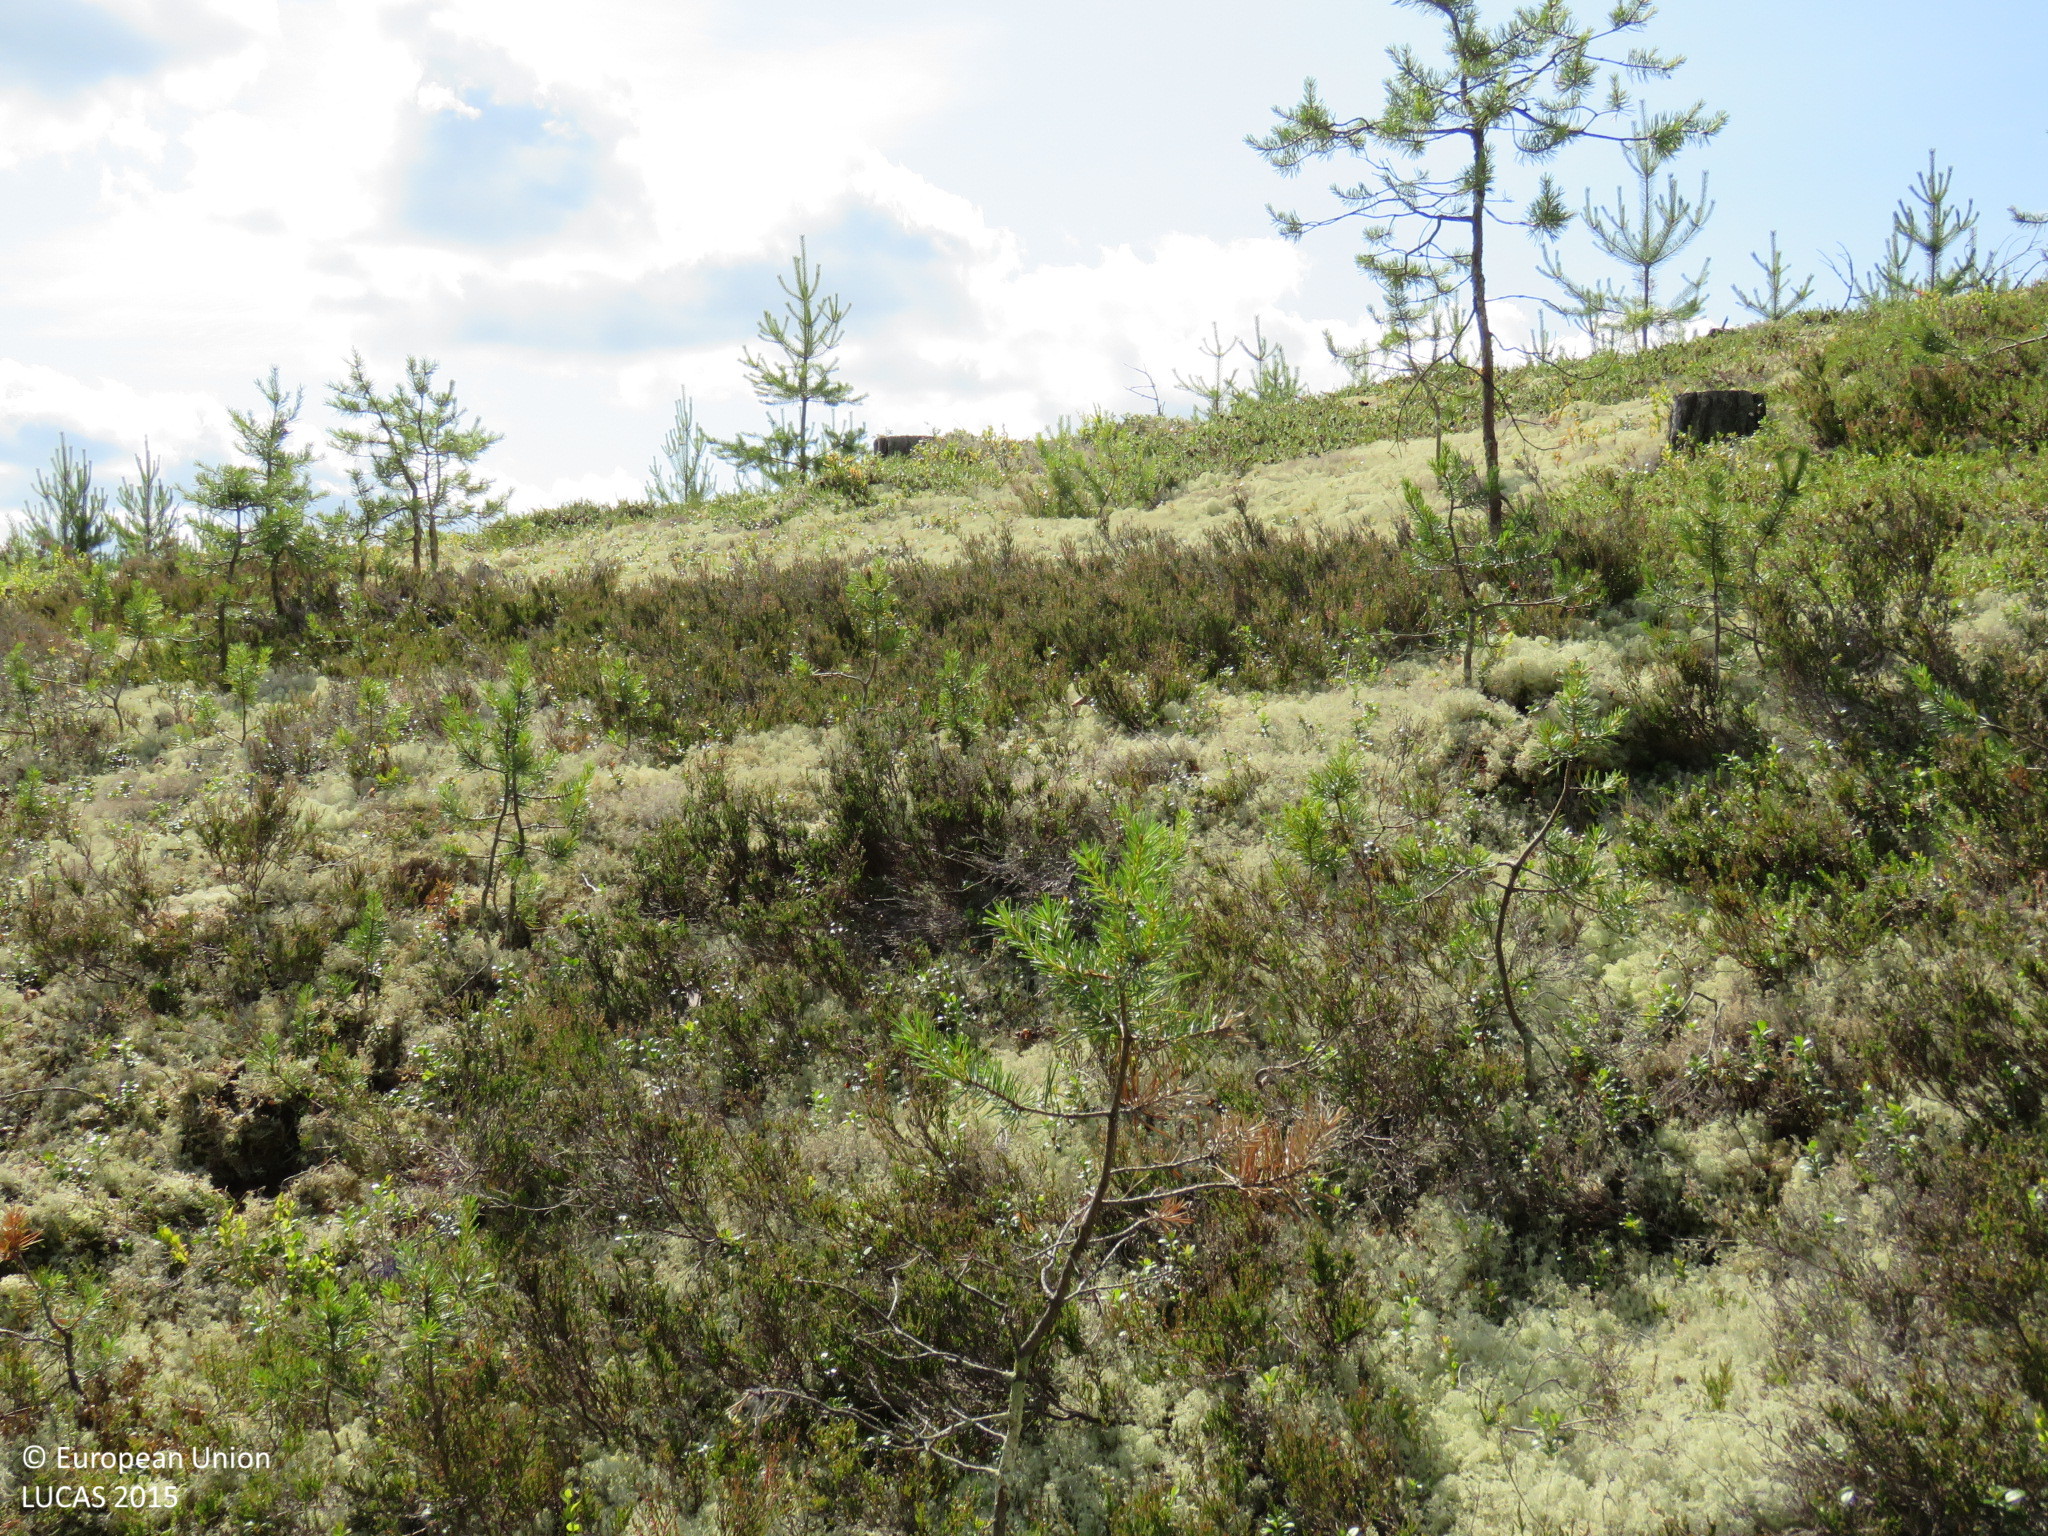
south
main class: Woodland
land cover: Pine dominated coniferous woodland
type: boreal forest
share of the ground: > 75 %
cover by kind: coniferous forest trees 75 %, lichens and mosses 15 %, shrubs 10 %
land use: Forestry
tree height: > 5 m
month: July
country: FI
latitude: 64.5342
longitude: 26.6049
